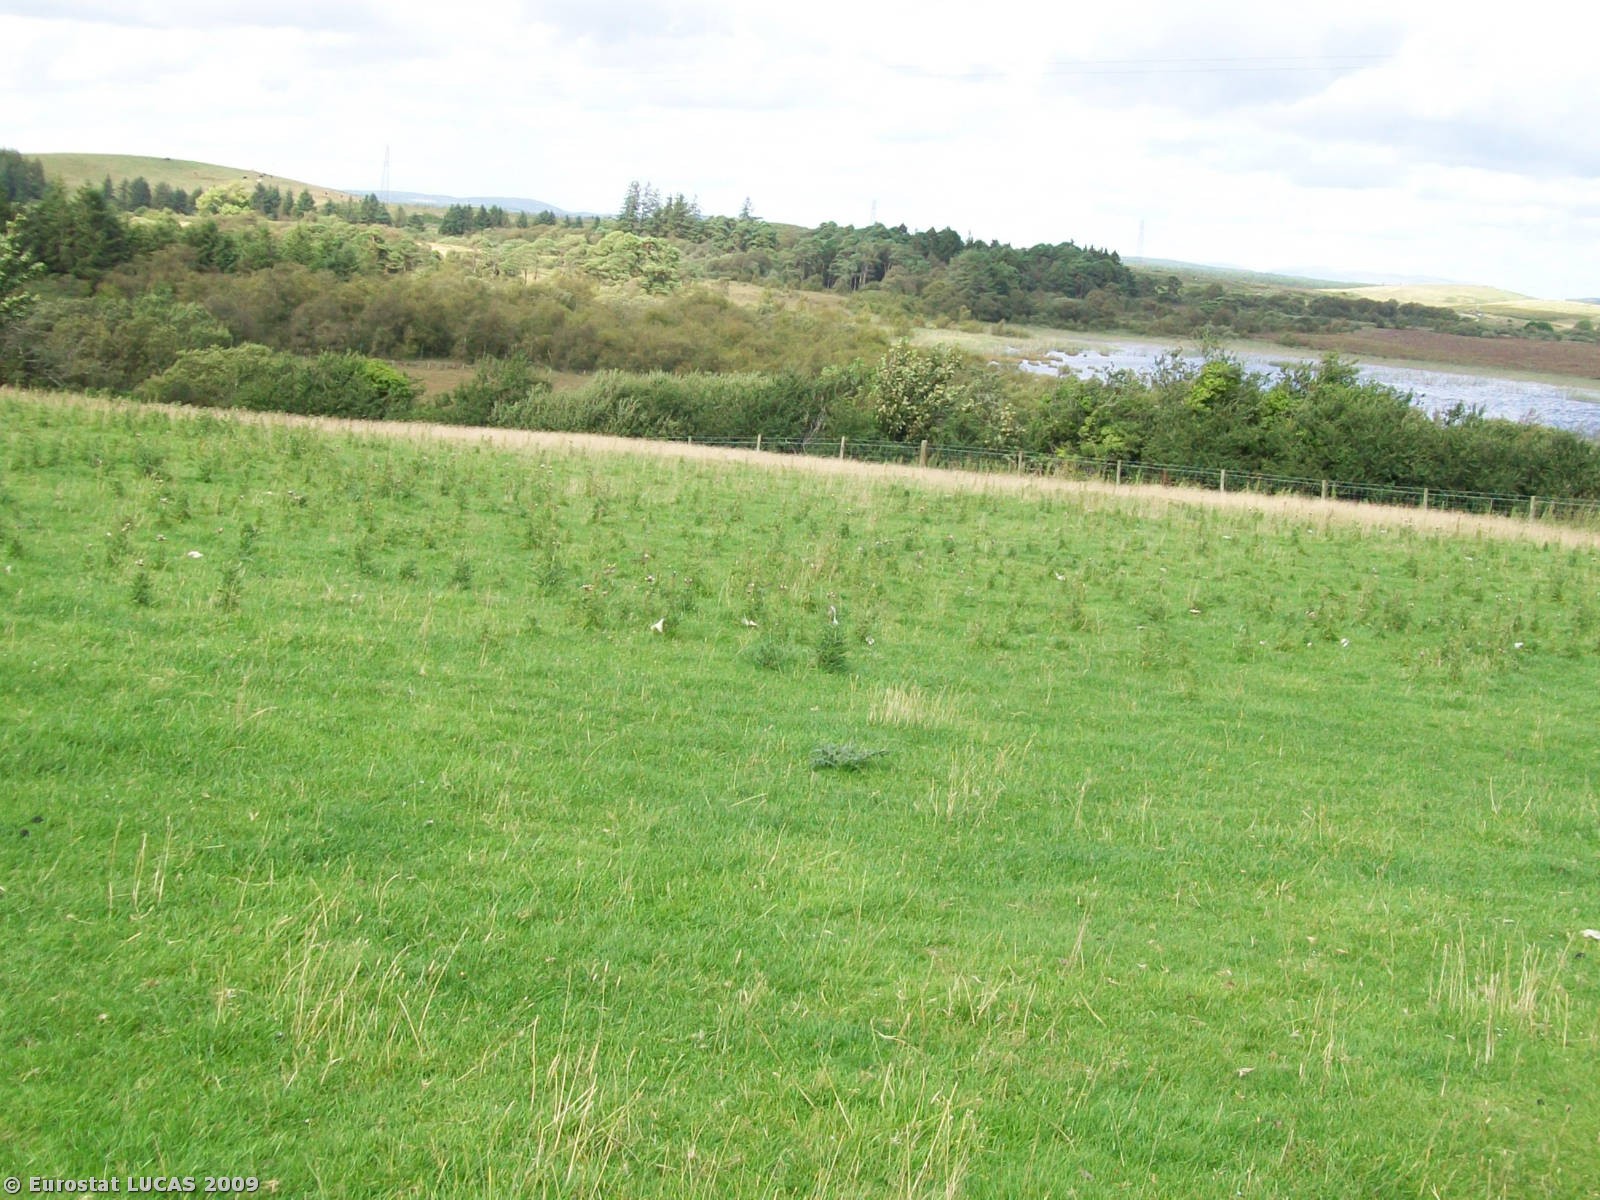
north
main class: Grassland
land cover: Grassland without tree/shrub cover
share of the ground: < 10 %
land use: Agriculture (excluding fallow land and kitchen gardens)
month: August
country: GB
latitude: 54.8932
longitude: -4.7163
